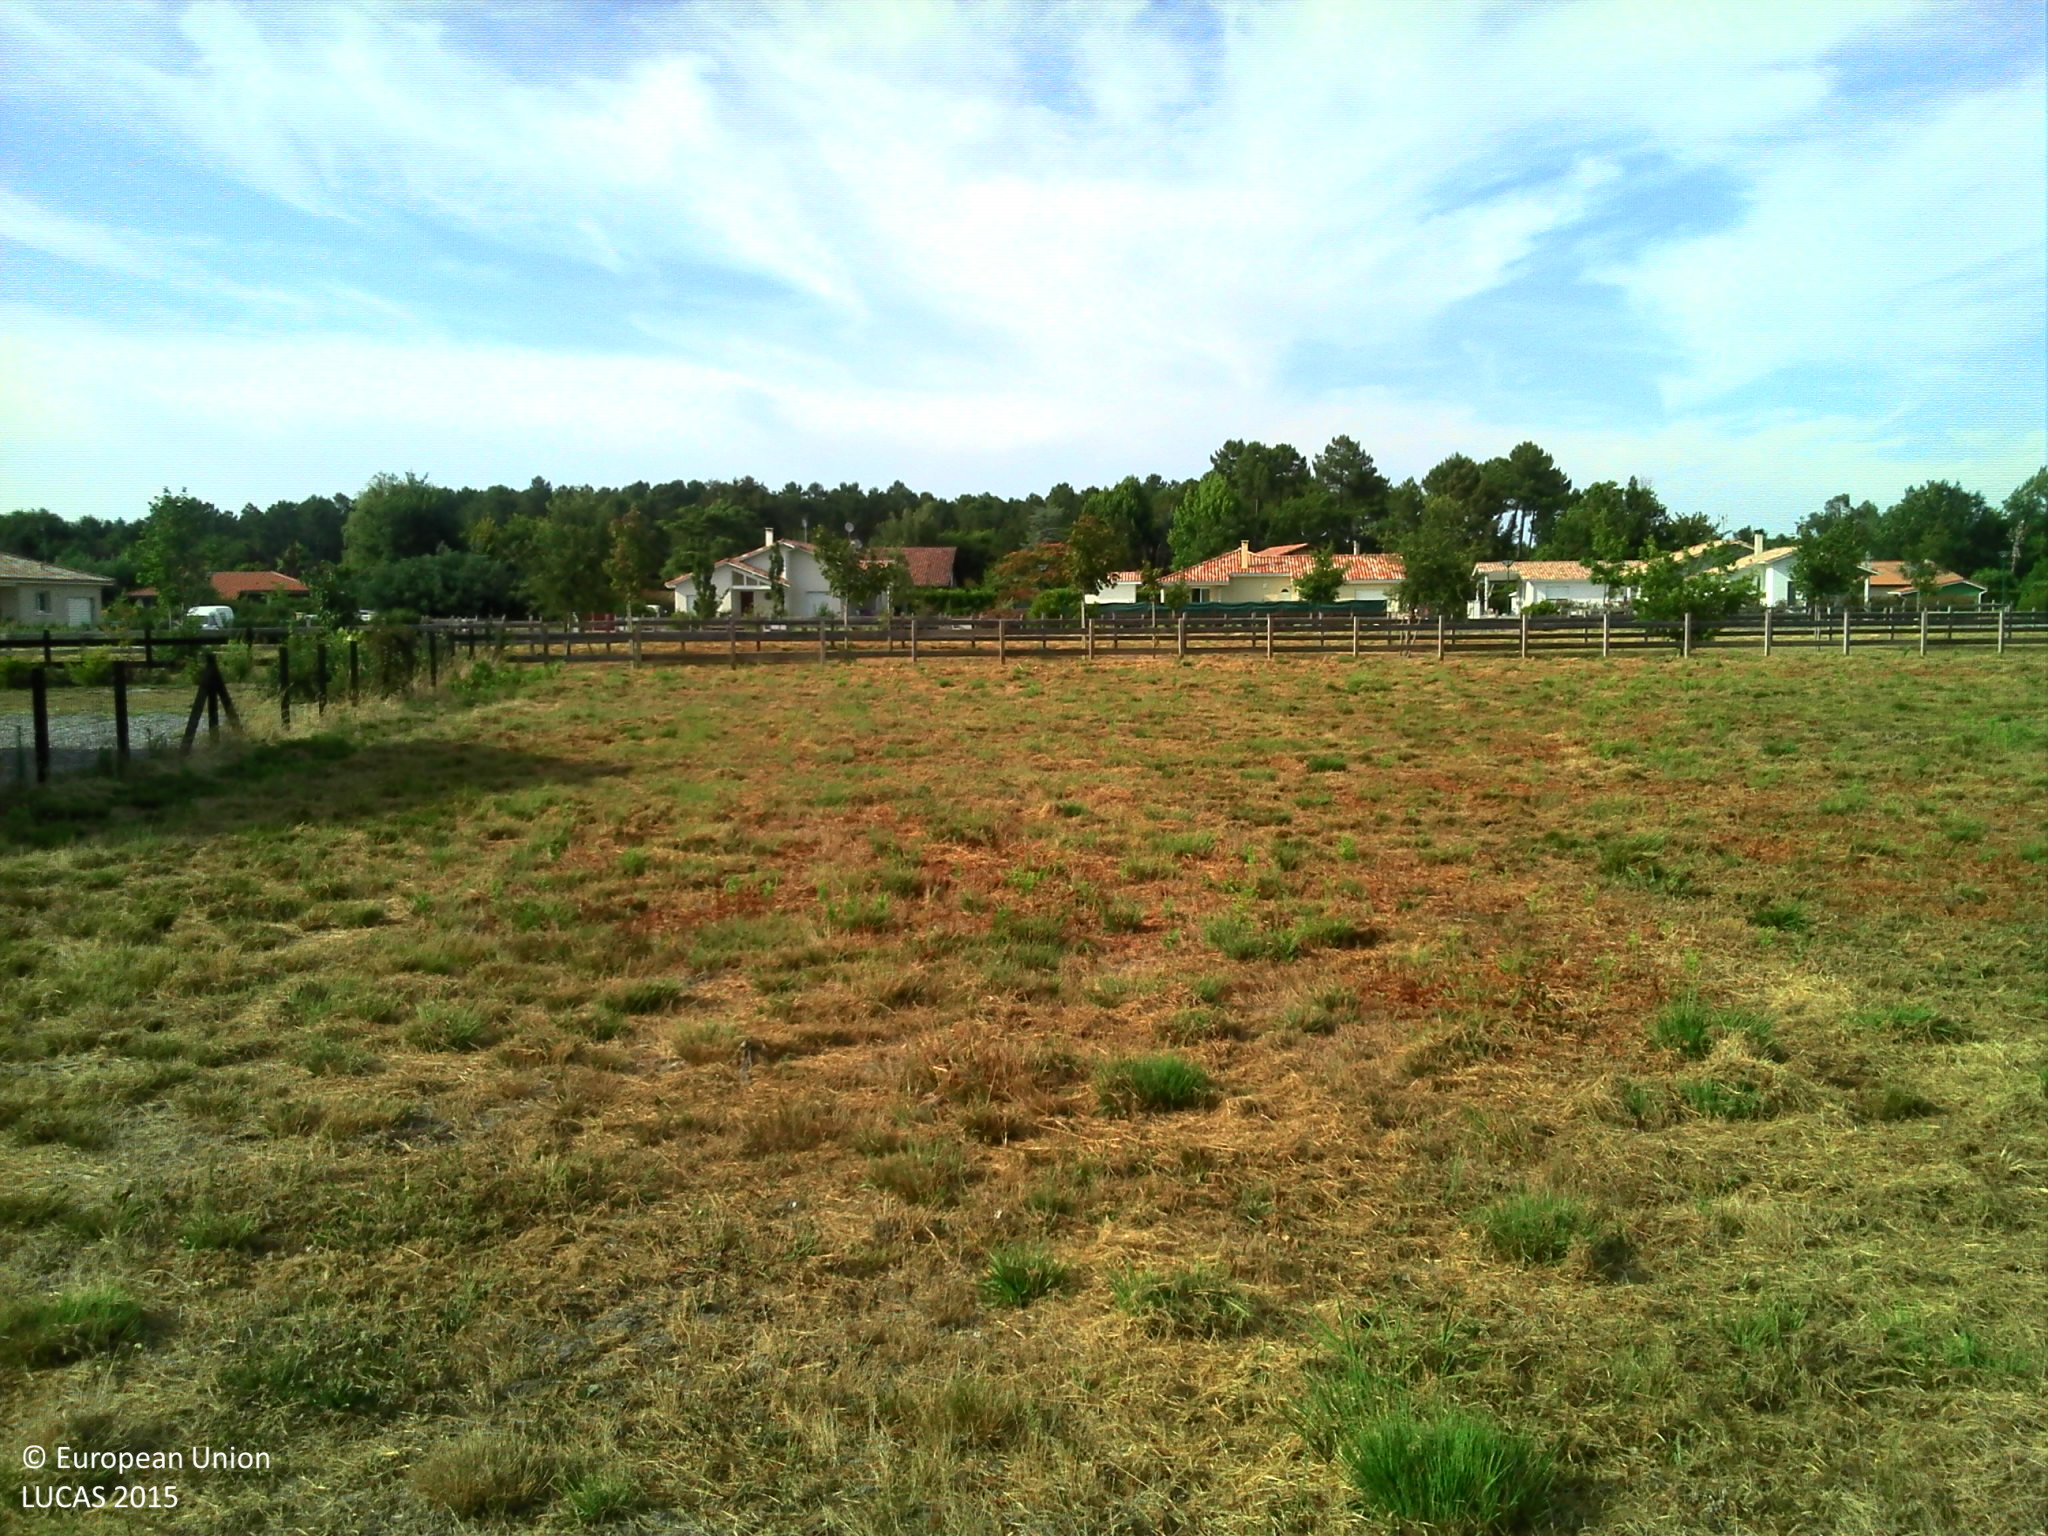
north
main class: Grassland
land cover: Grassland without tree/shrub cover
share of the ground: > 75 %
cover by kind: herbaceous plants 100 %
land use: Residential
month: July
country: FR
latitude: 43.9117
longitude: -1.3141
